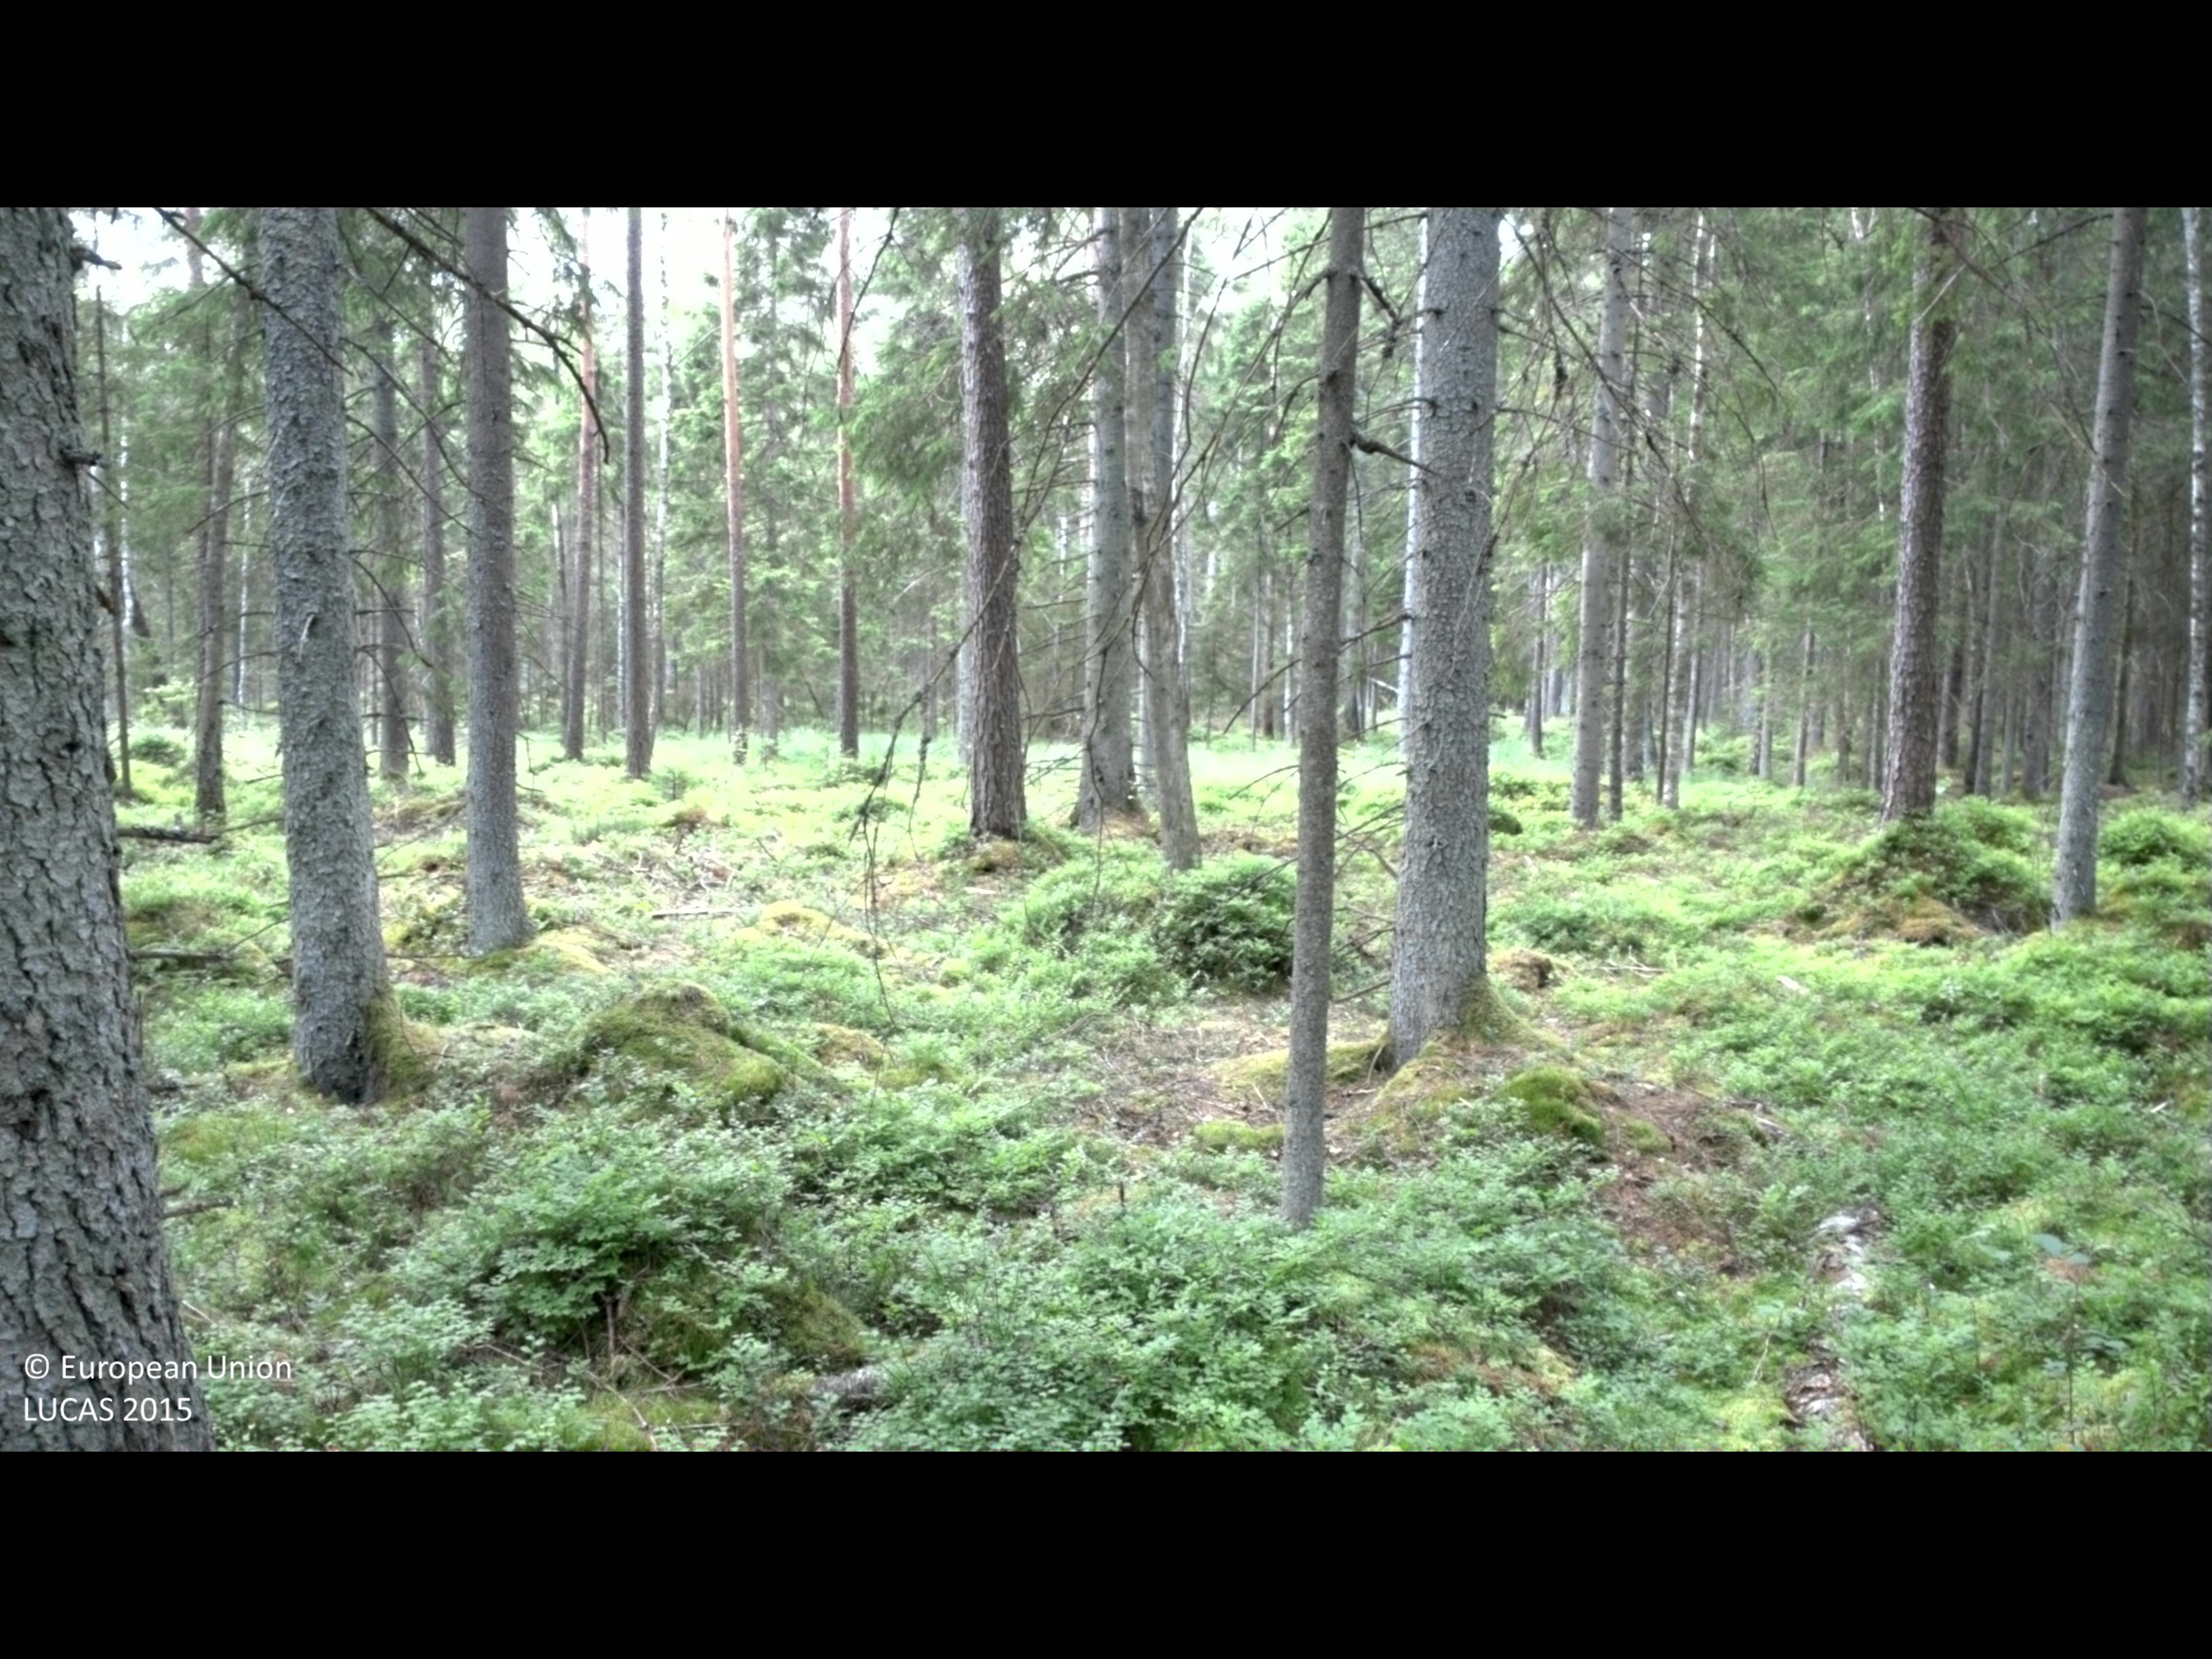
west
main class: Woodland
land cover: Spruce dominated coniferous woodland
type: boreal forest
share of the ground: 50 - 75 %
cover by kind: coniferous forest trees 65 %, shrubs 30 %, lichens and mosses 5 %
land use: Forestry
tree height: > 5 m
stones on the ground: < 10 %
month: July
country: SE
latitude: 56.4930
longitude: 13.7490
